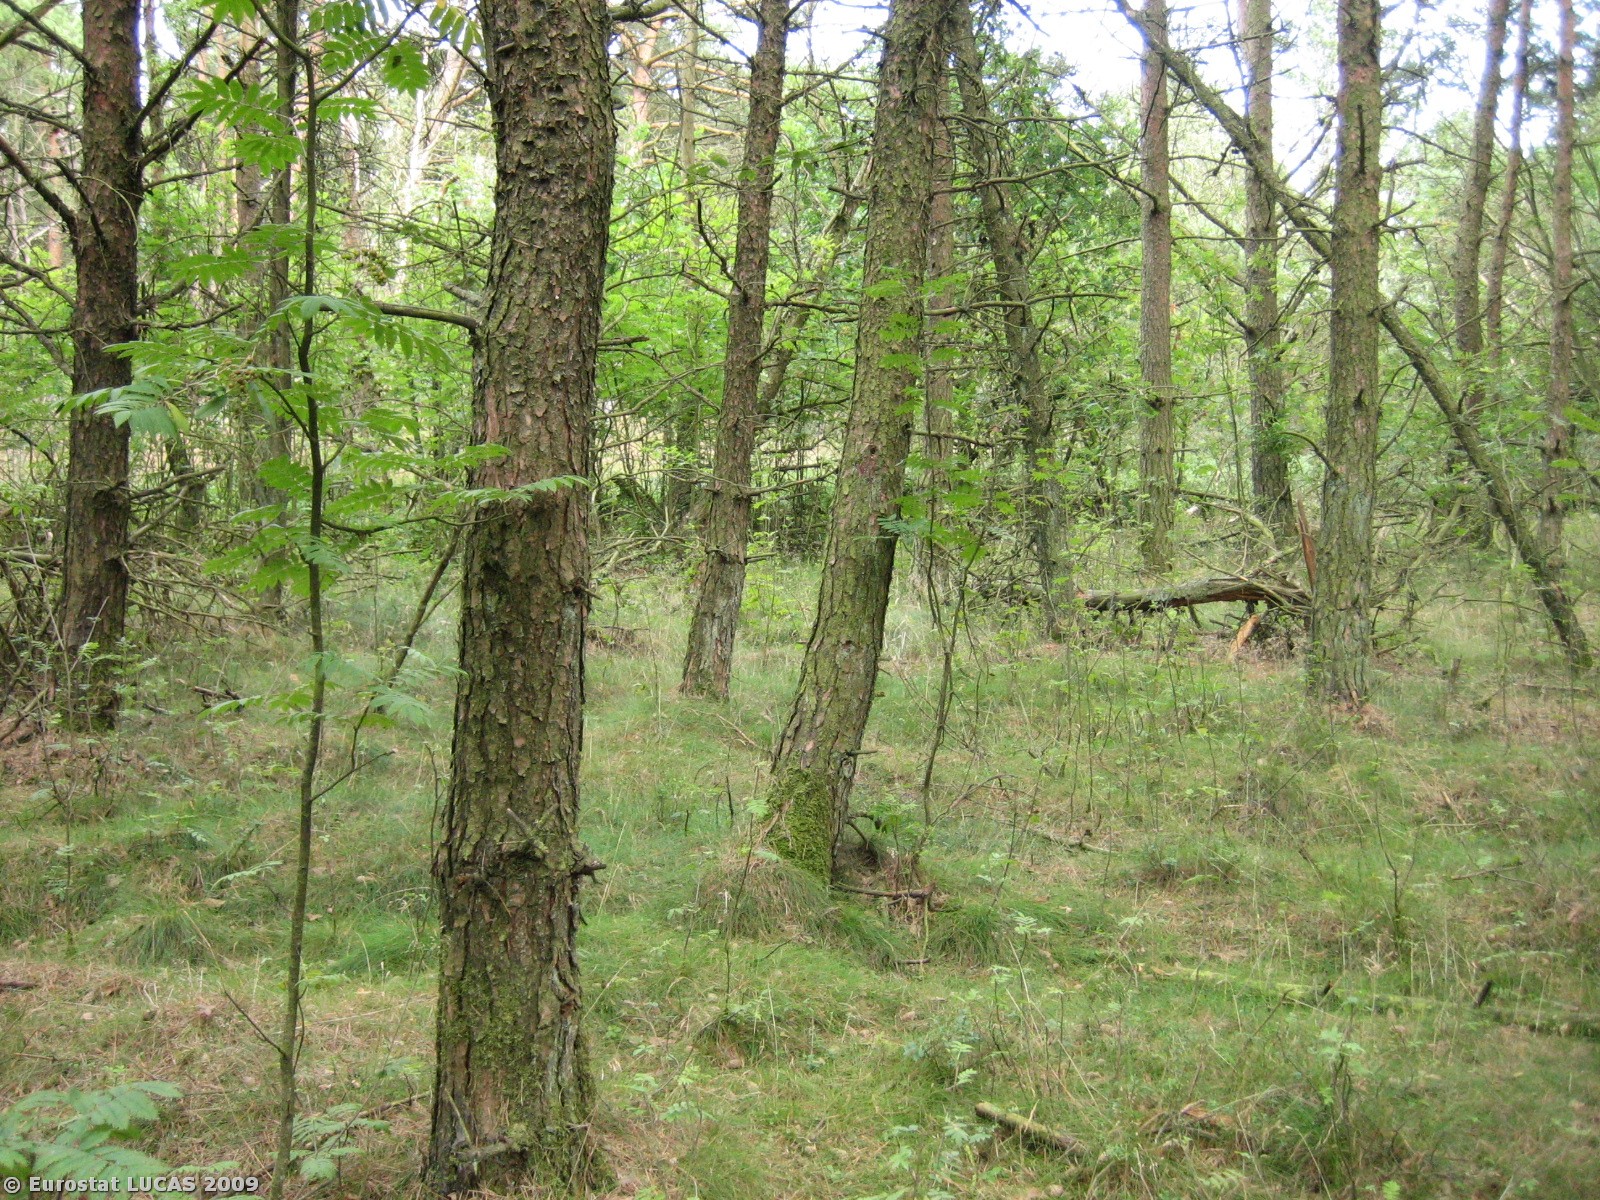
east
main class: Woodland
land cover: Coniferous woodland
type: hemiboreal forest and nemoral coniferous forest and mixed broadleaved-coniferous forest
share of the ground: > 75 %
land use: Forestry
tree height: > 5 m
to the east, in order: Coniferous woodland; Broadleaved woodland; Coniferous woodland; Grassland with sparse tree/shrub cover; Coniferous woodland; Broadleaved woodland; Coniferous woodland
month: July
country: DK
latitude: 55.7261
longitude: 8.2343
